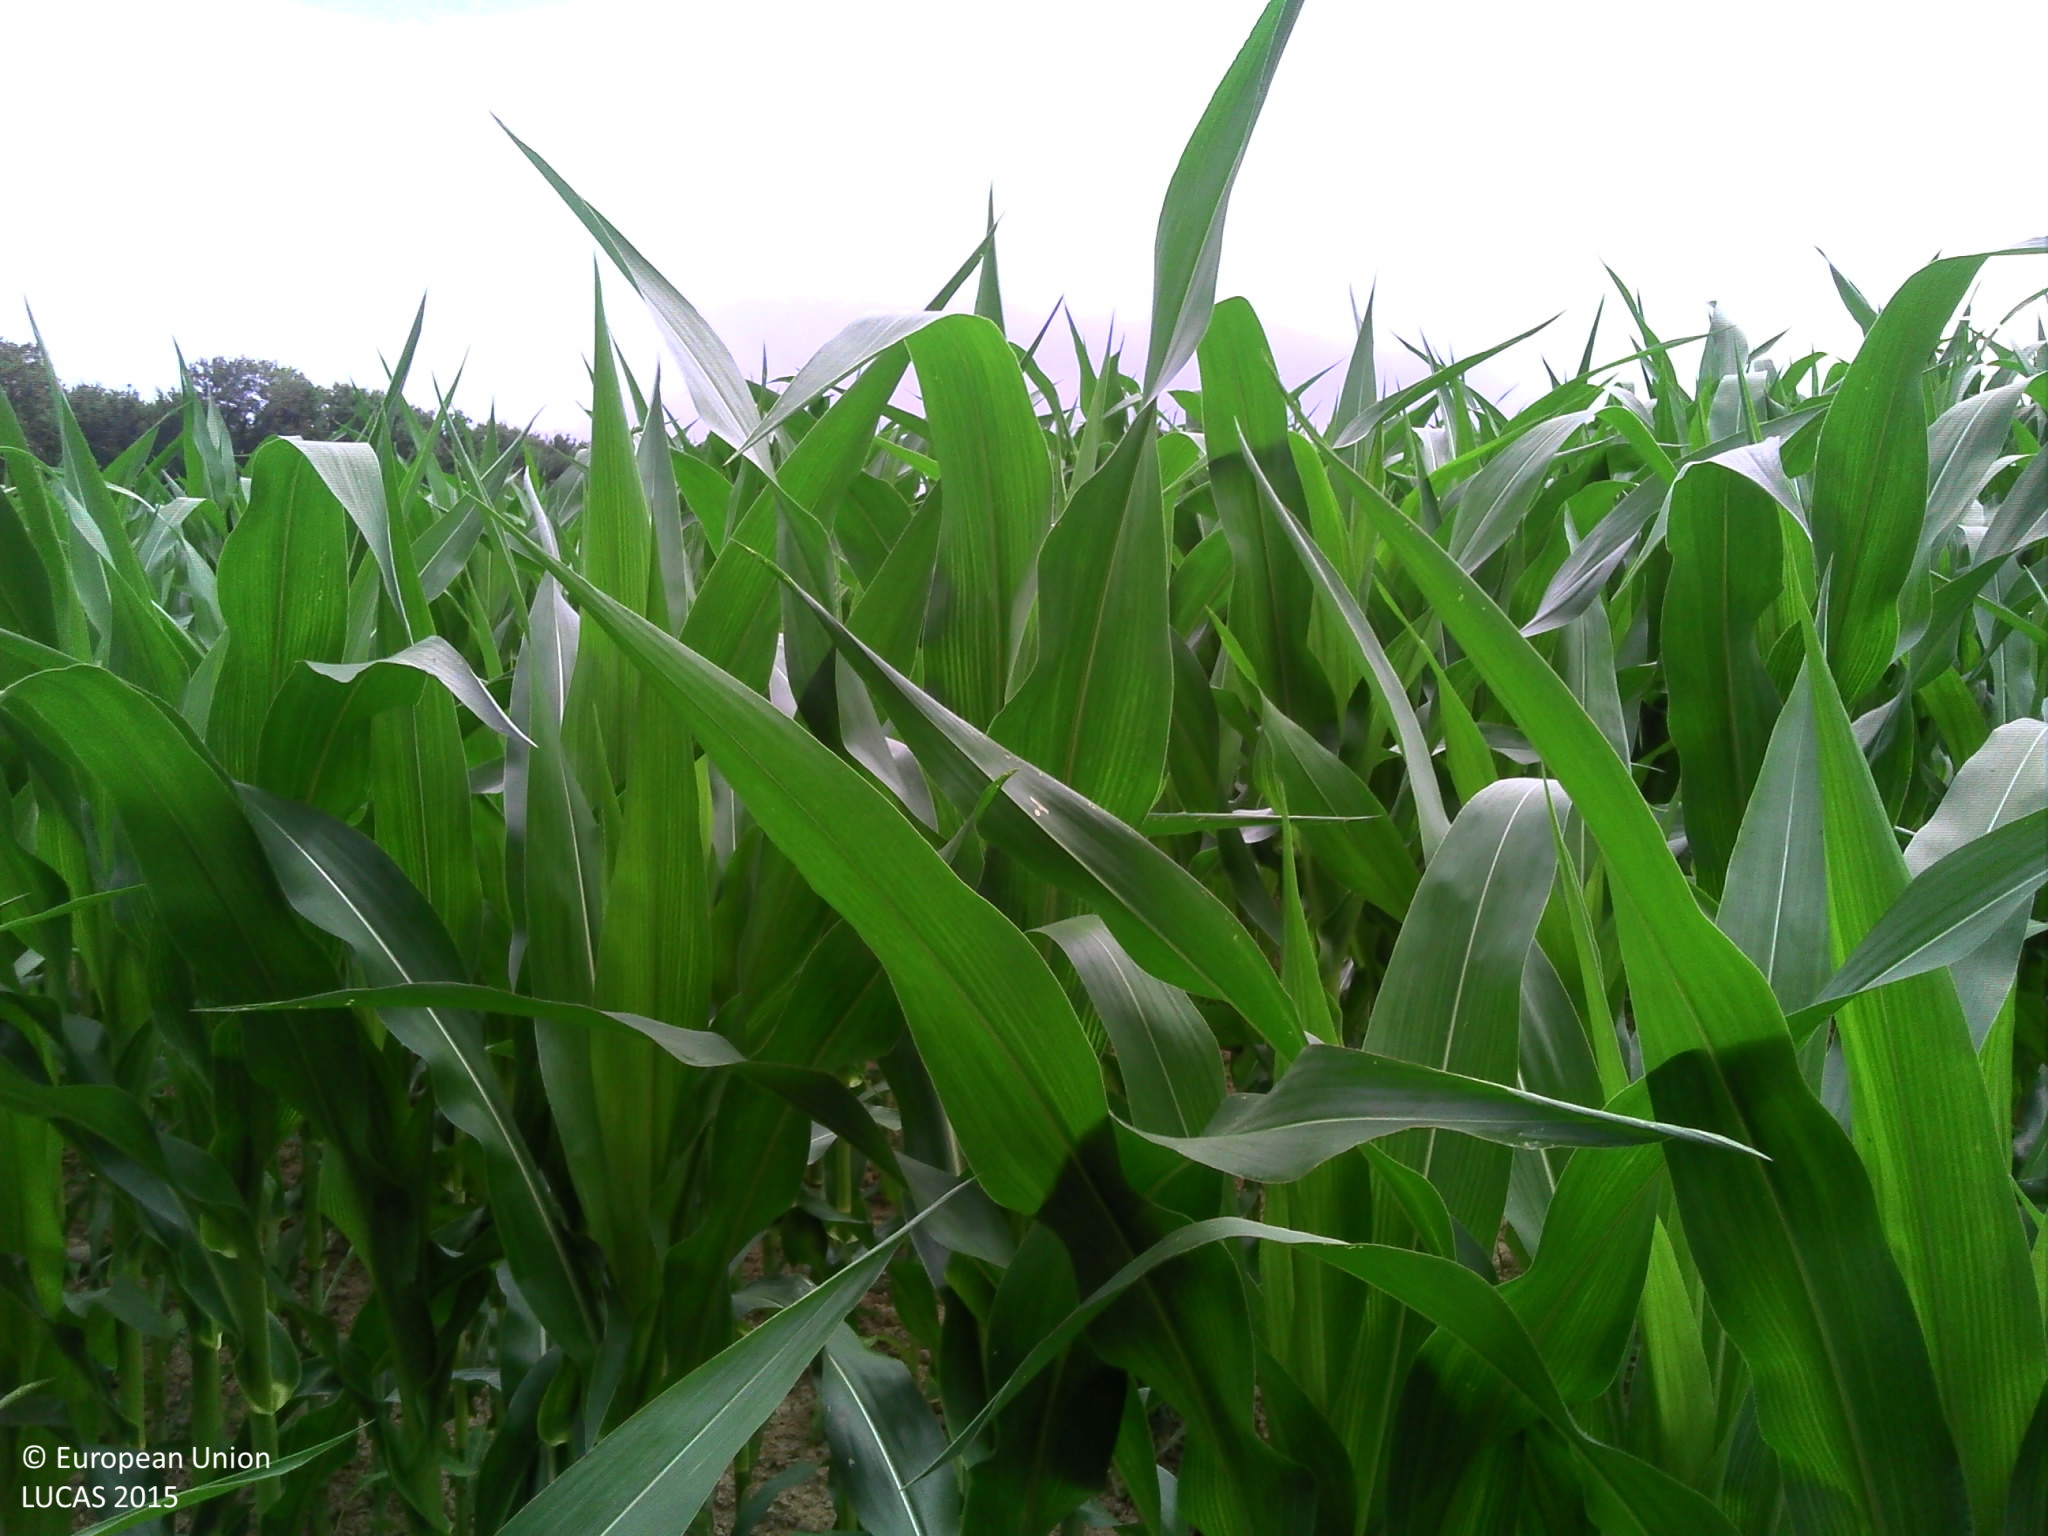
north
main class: Cropland
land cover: Maize
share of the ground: 50 - 75 %
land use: Agriculture (excluding fallow land and kitchen gardens)
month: July
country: FR
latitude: 43.5751
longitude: -0.7228
